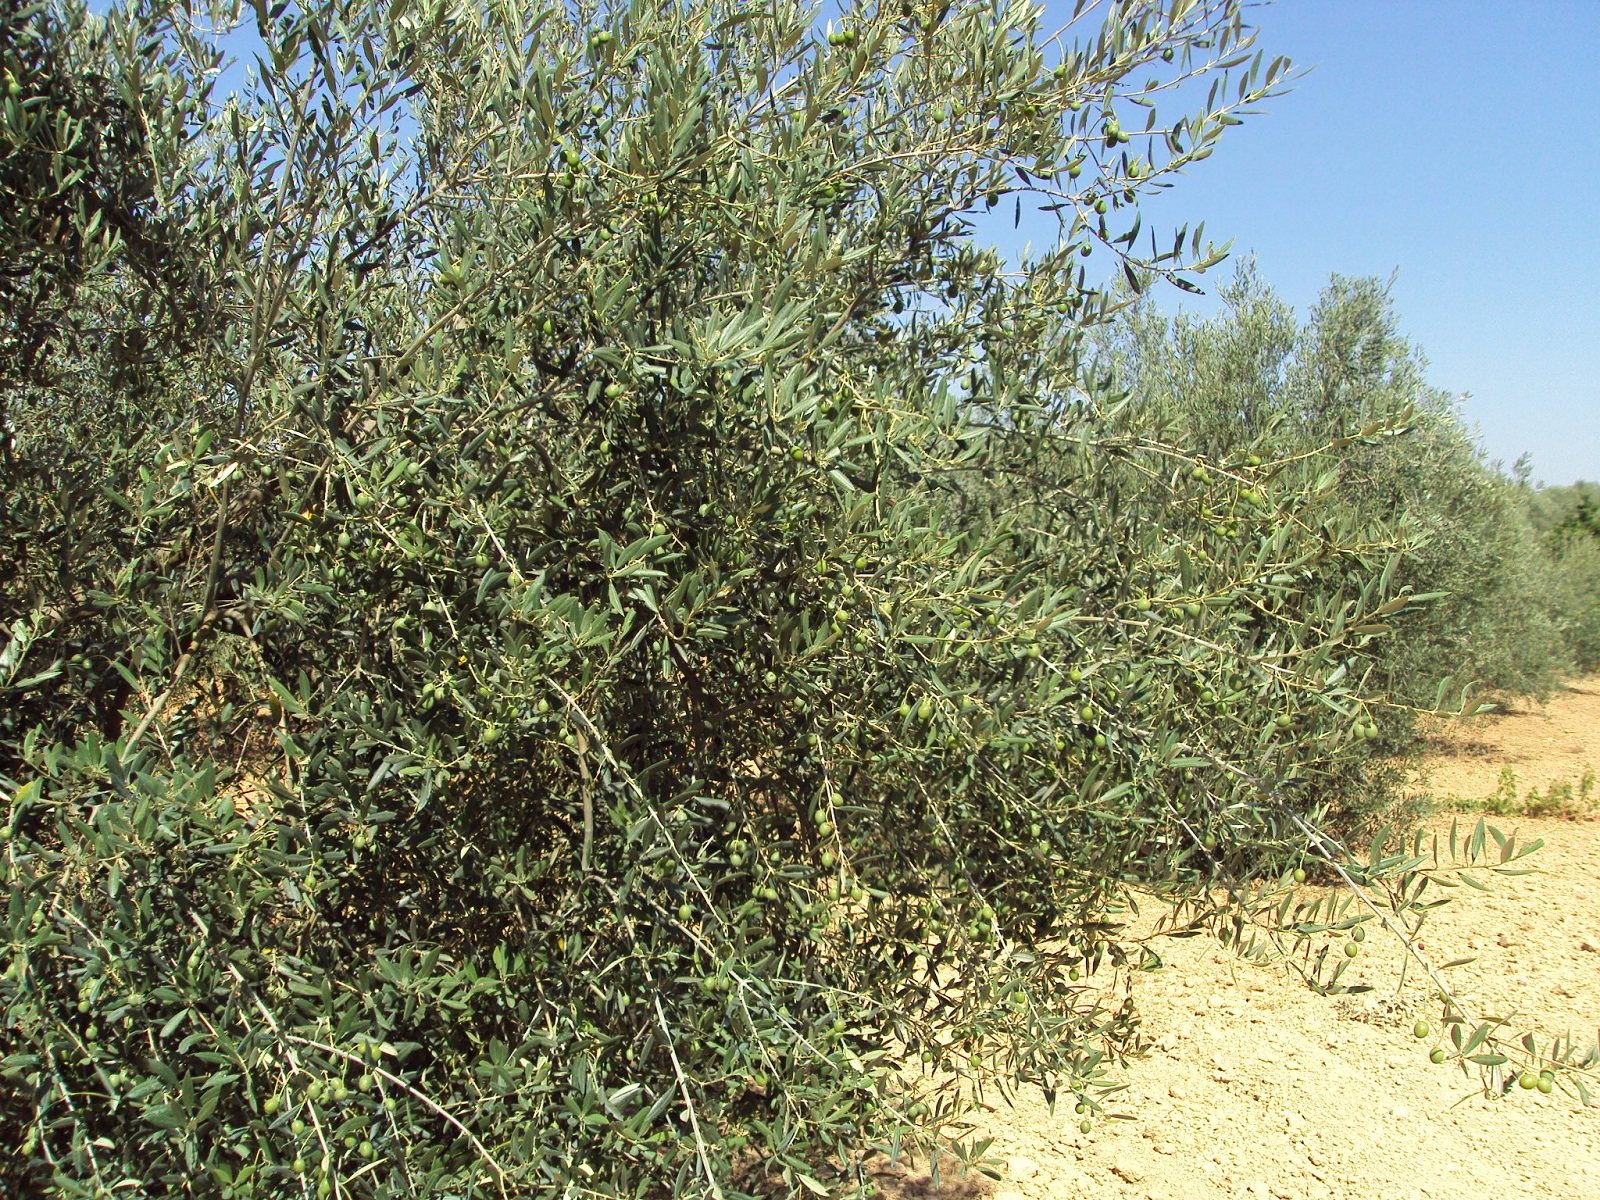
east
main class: Cropland
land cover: Olive groves
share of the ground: 50 - 75 %
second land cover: Other bare soil
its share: > 75 %
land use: Agriculture (excluding fallow land and kitchen gardens)
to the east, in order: Olive groves; Other bare soil; Vineyards; Ditches and canals; Vineyards; Oranges; Shruby margins; Triticale; Shruby margins; Fences; Olive groves; Oranges; Olive groves; Fences; Managed hedges; Grass margins; Tracks; Grass margins
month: June
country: ES
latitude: 37.2923
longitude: -6.6033
